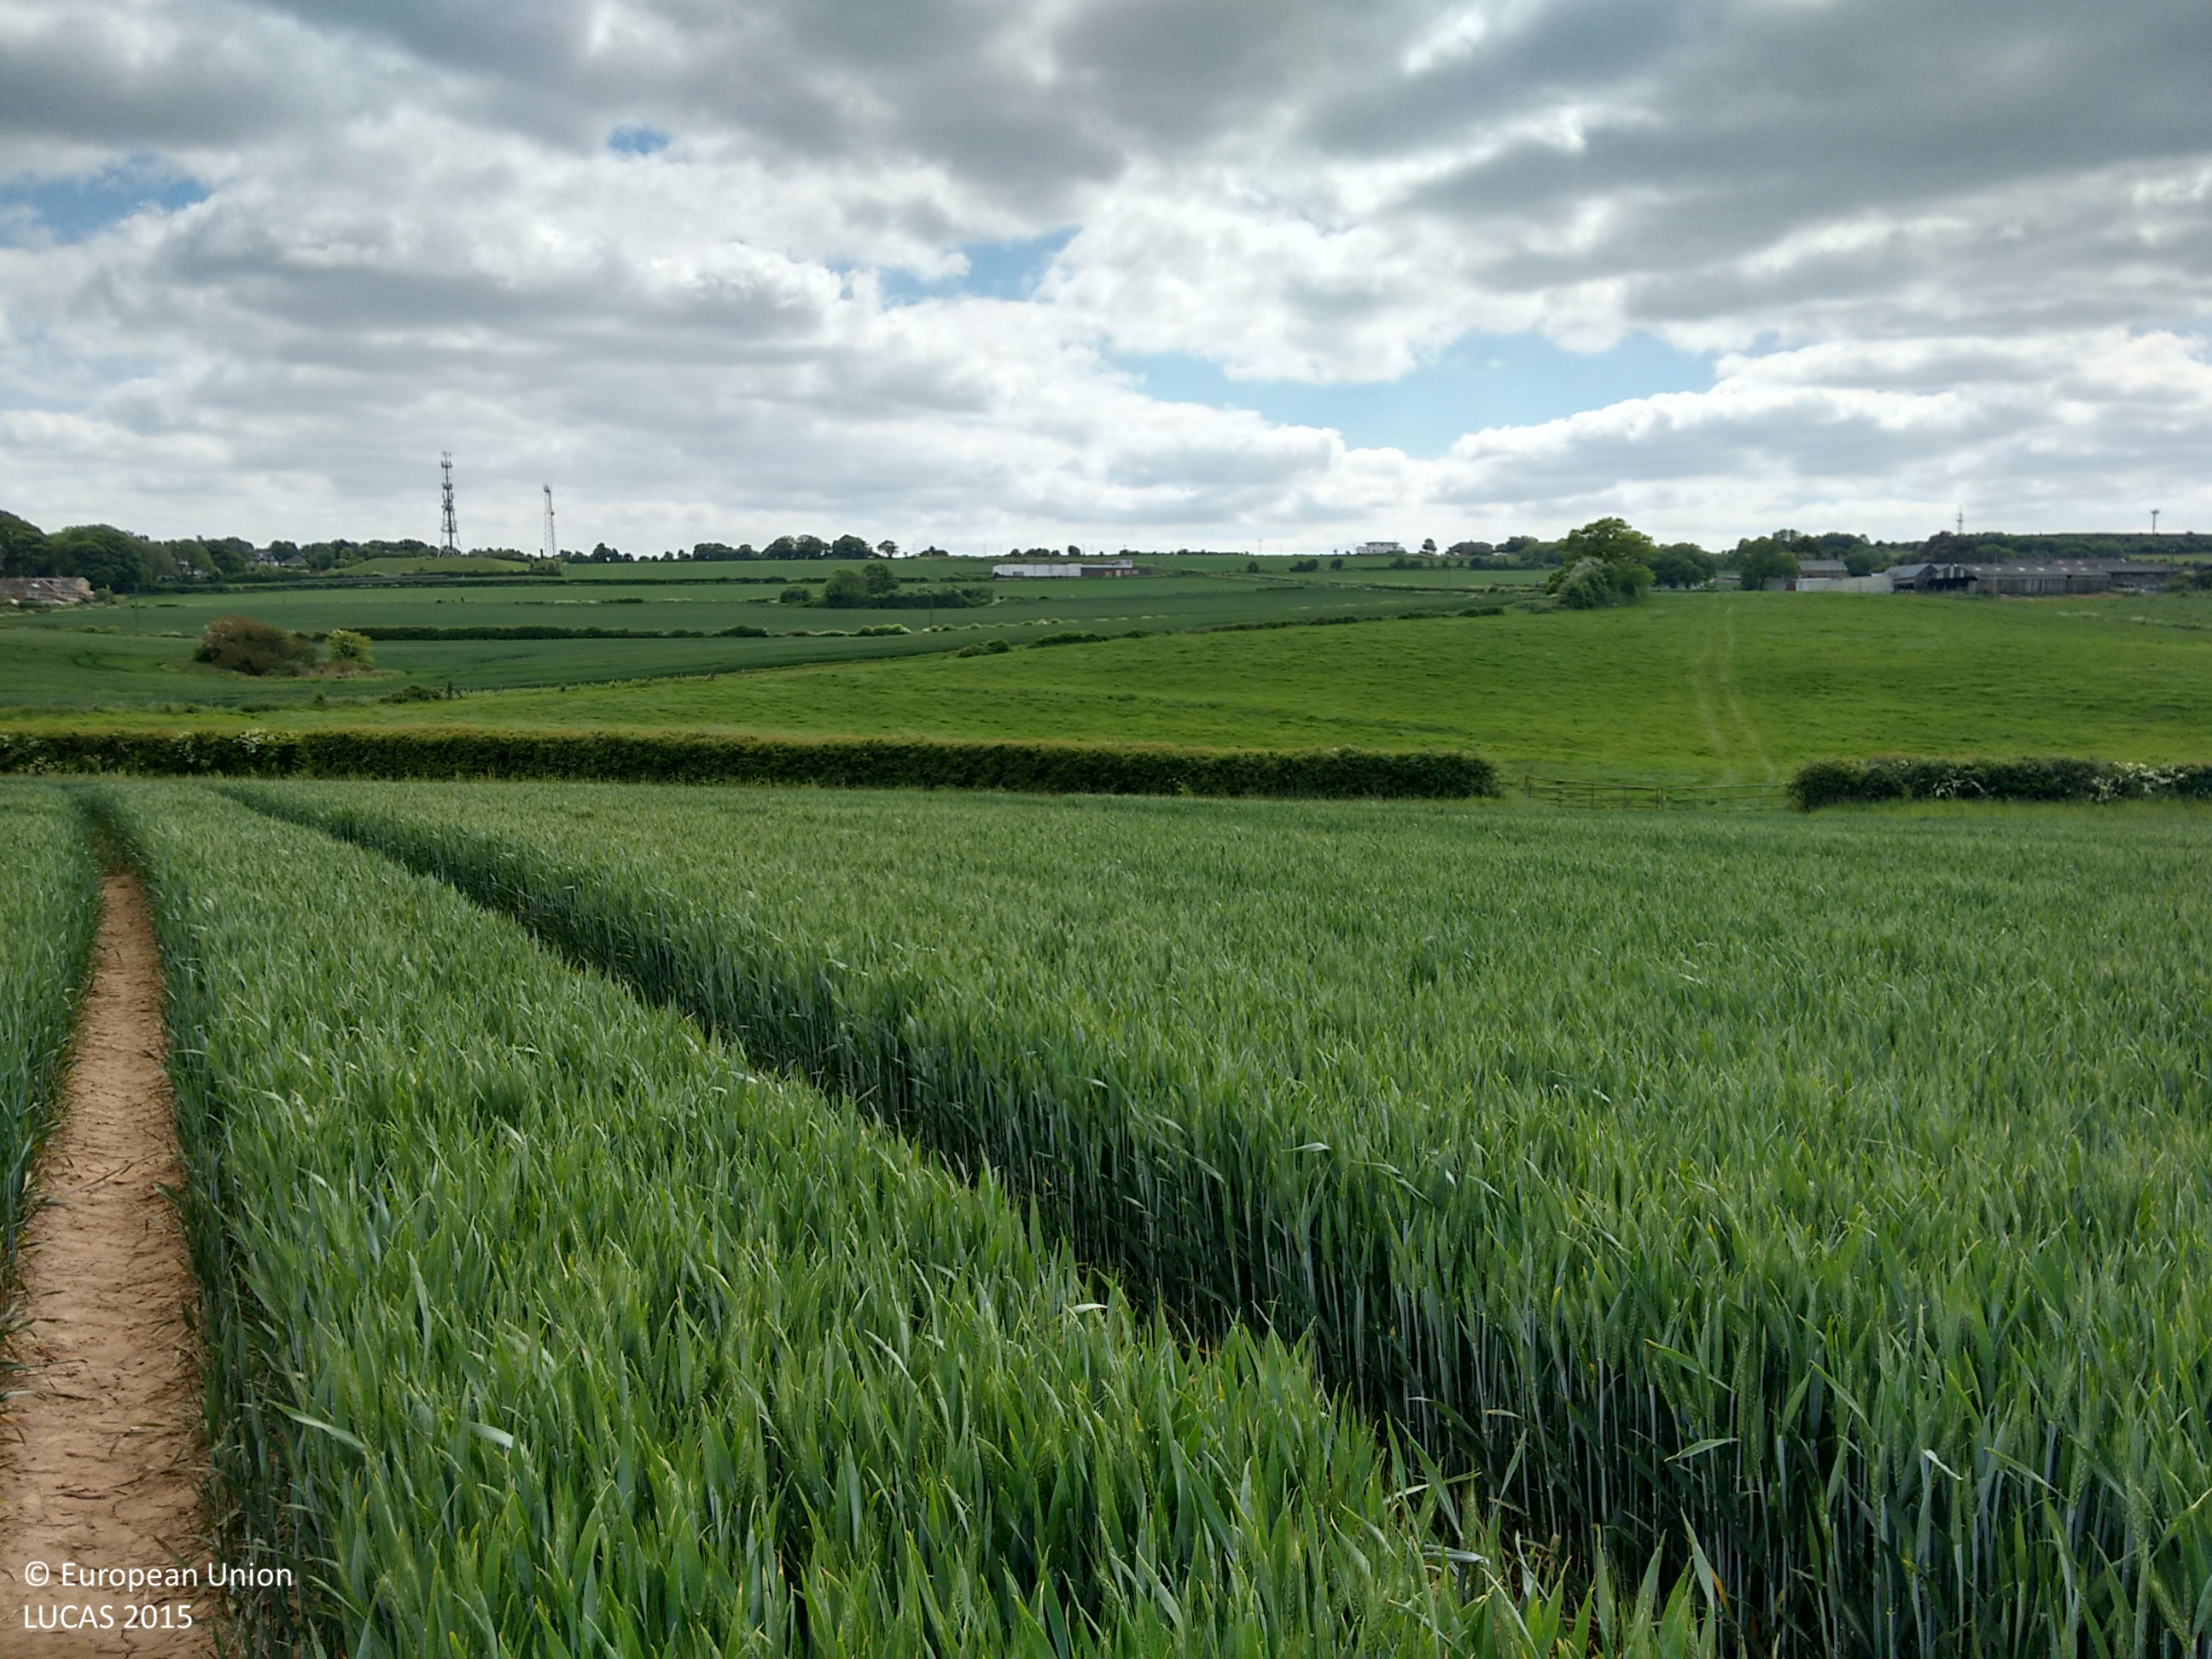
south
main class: Cropland
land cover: Common wheat
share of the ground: > 75 %
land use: Agriculture (excluding fallow land and kitchen gardens)
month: May
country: GB
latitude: 50.8610
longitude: -1.0556
